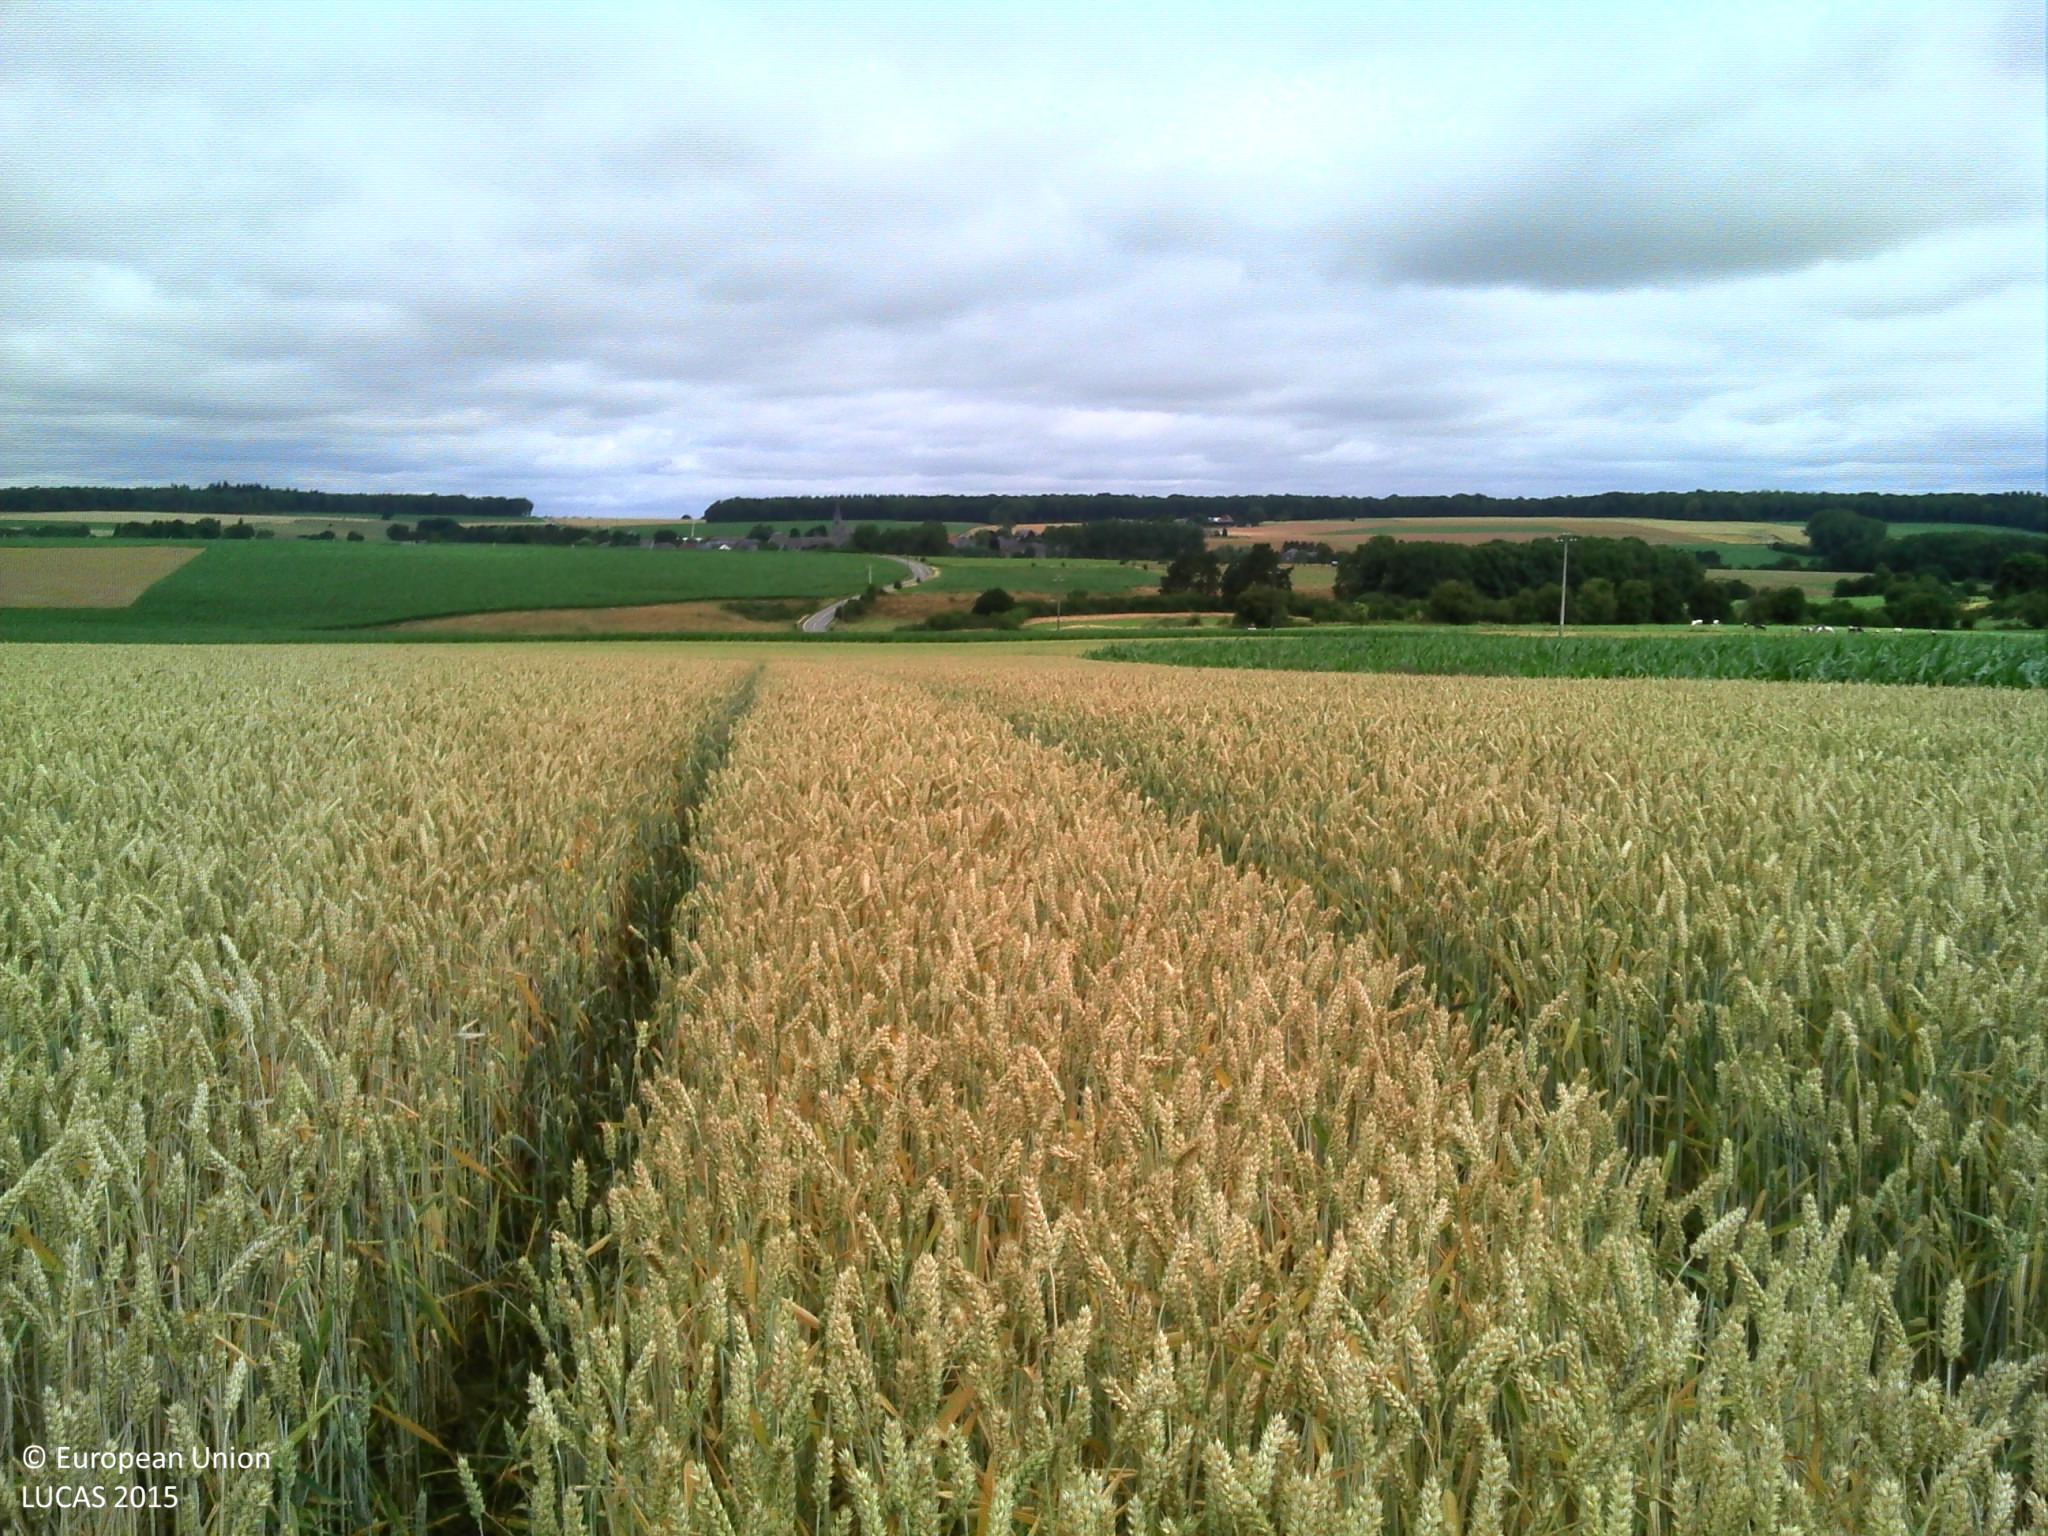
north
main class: Cropland
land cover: Common wheat
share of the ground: > 75 %
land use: Agriculture (excluding fallow land and kitchen gardens)
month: July
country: BE
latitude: 50.2404
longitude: 4.6823
